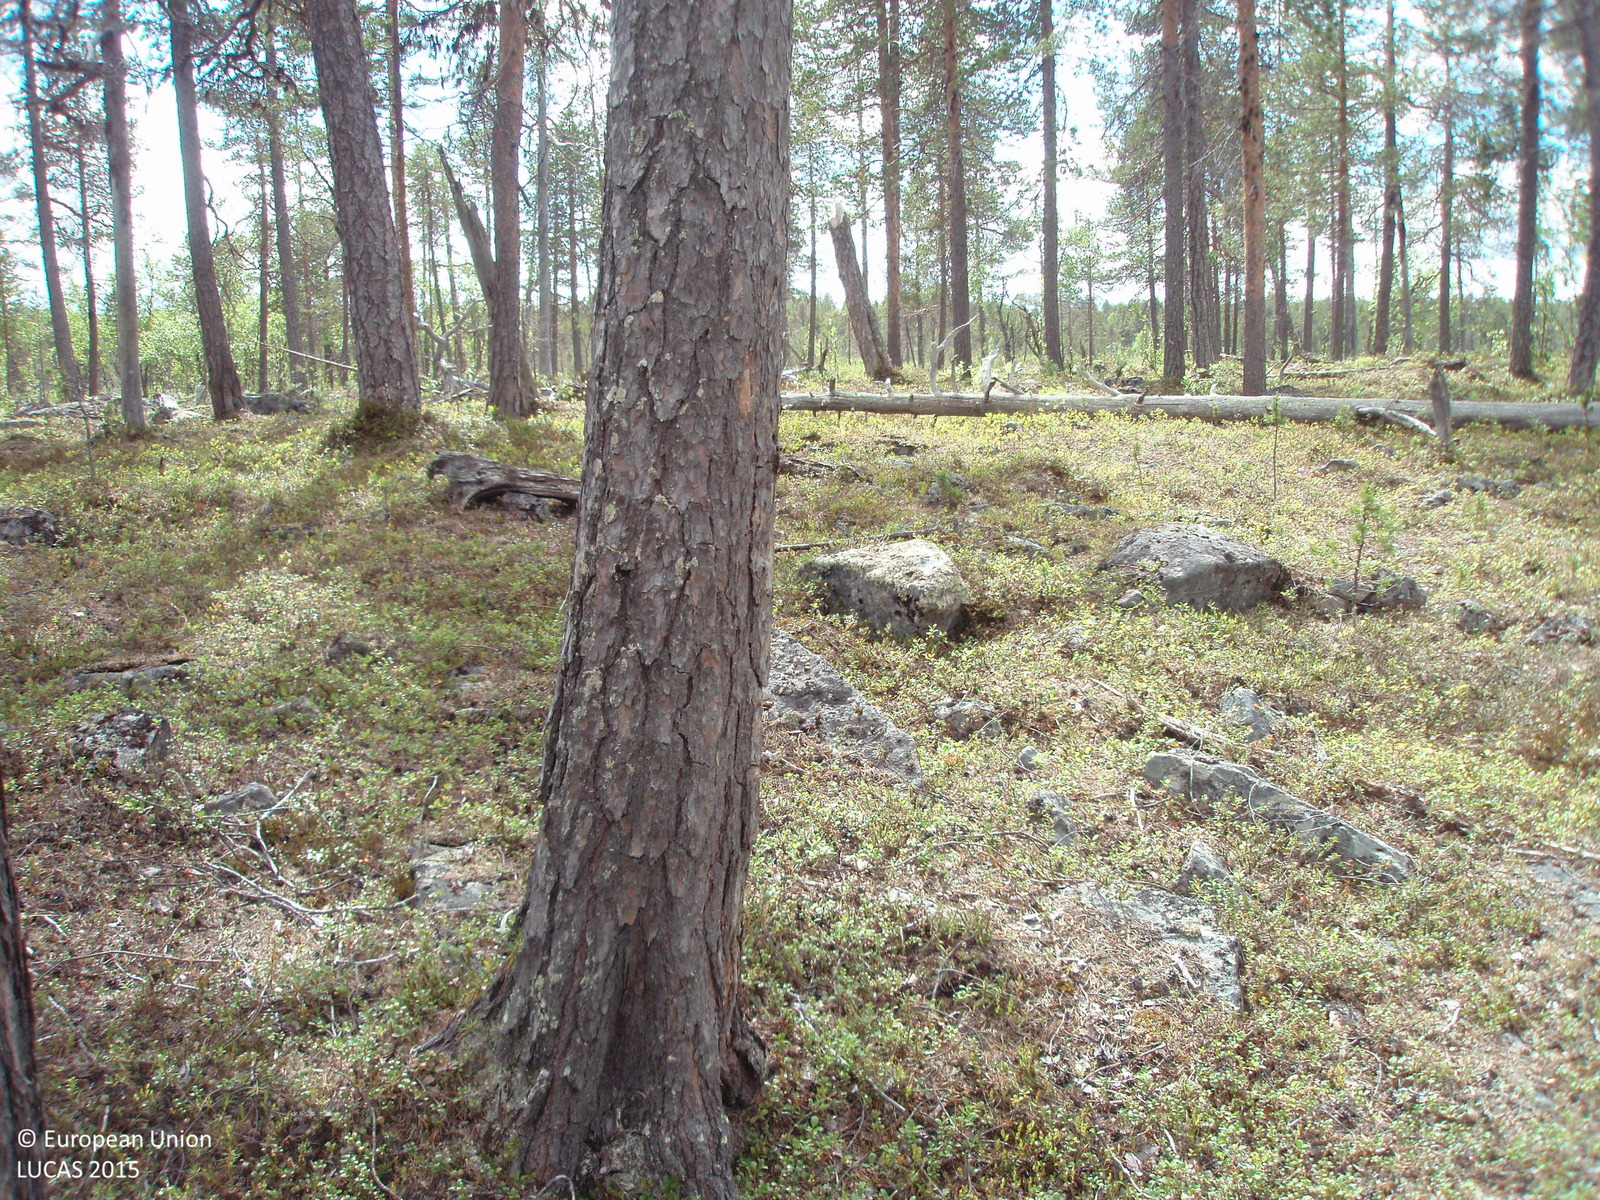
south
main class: Woodland
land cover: Pine dominated coniferous woodland
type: boreal forest
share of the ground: 50 - 75 %
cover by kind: coniferous forest trees 50 %, shrubs 35 %, broadleaved forest trees 5 %, lichens and mosses 5 %, unconsolidated bare surface 5 %
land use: Forestry
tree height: > 5 m
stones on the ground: > 50 %
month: July
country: FI
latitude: 68.8866
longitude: 25.8292
